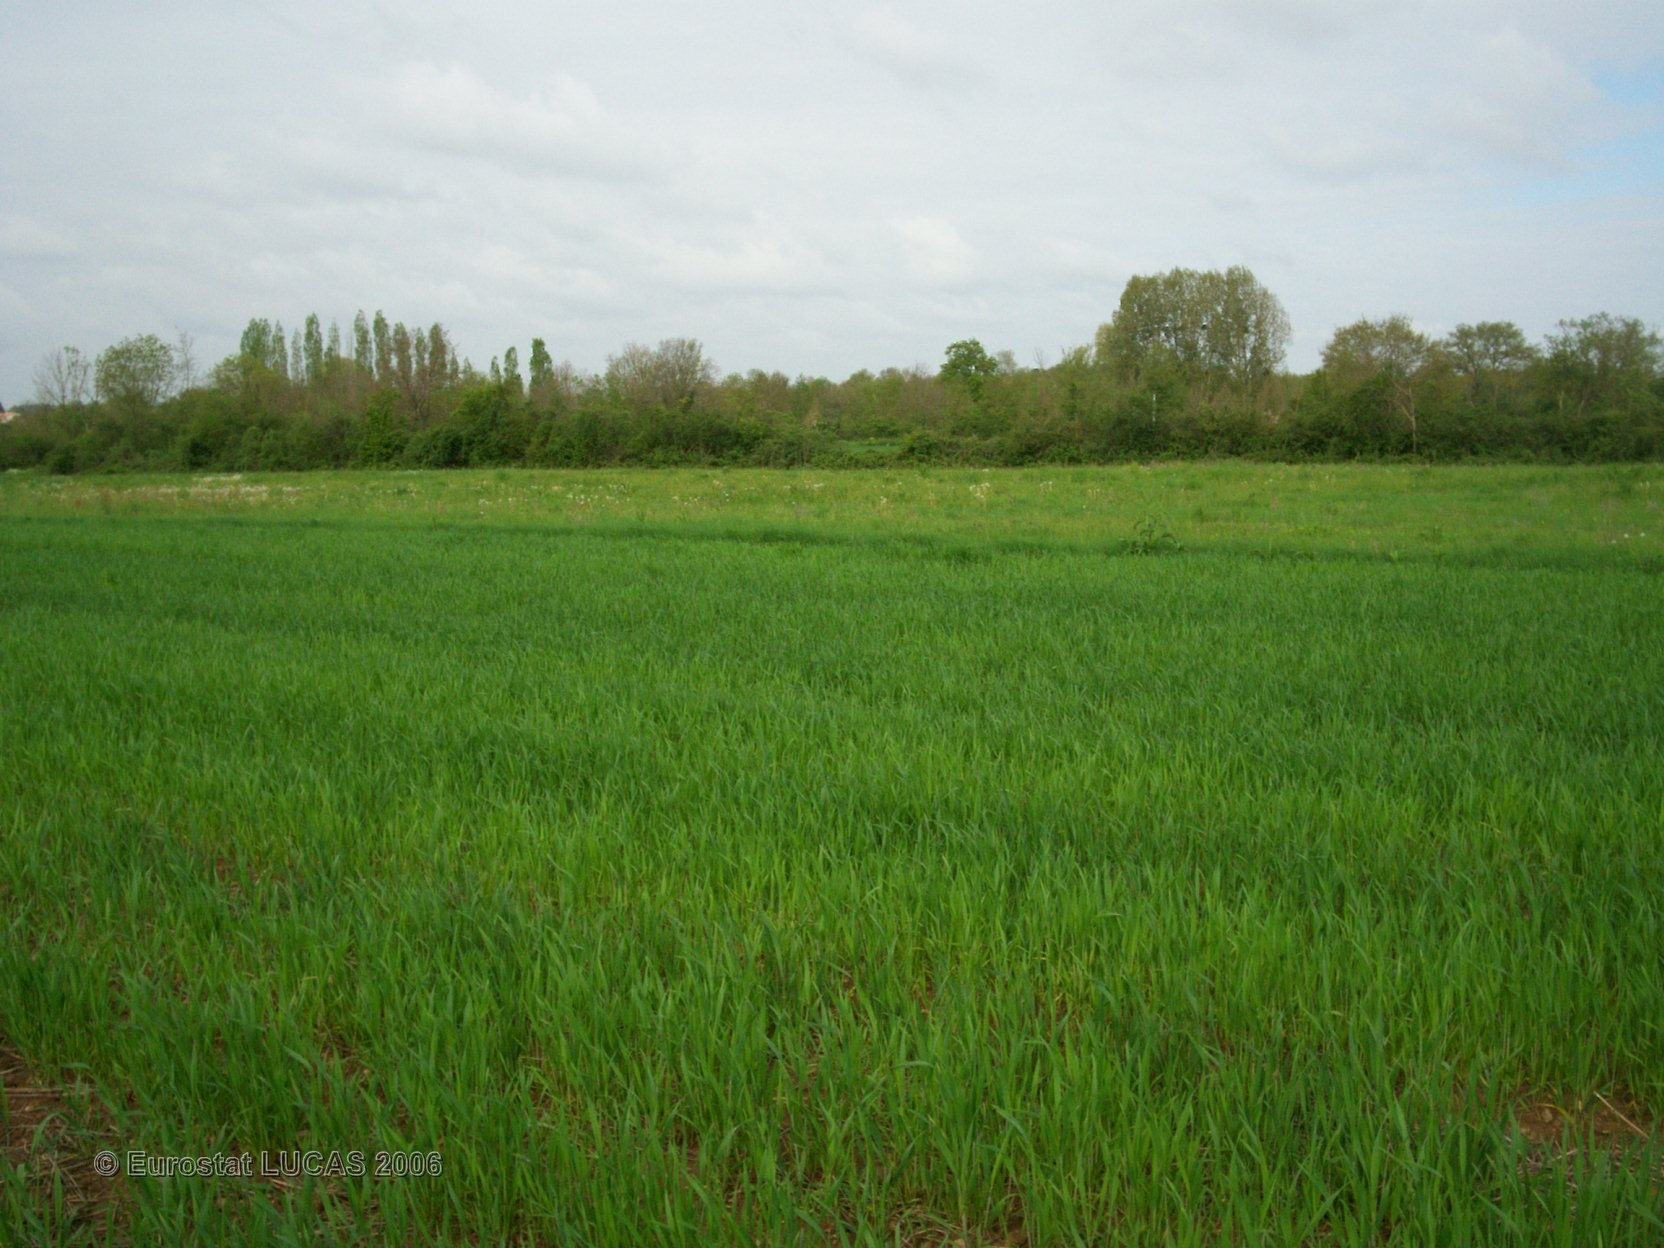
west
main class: Cropland
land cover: Common wheat
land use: Agriculture (excluding fallow land and kitchen gardens)
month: April
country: FR
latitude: 47.0116
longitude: -0.3267
